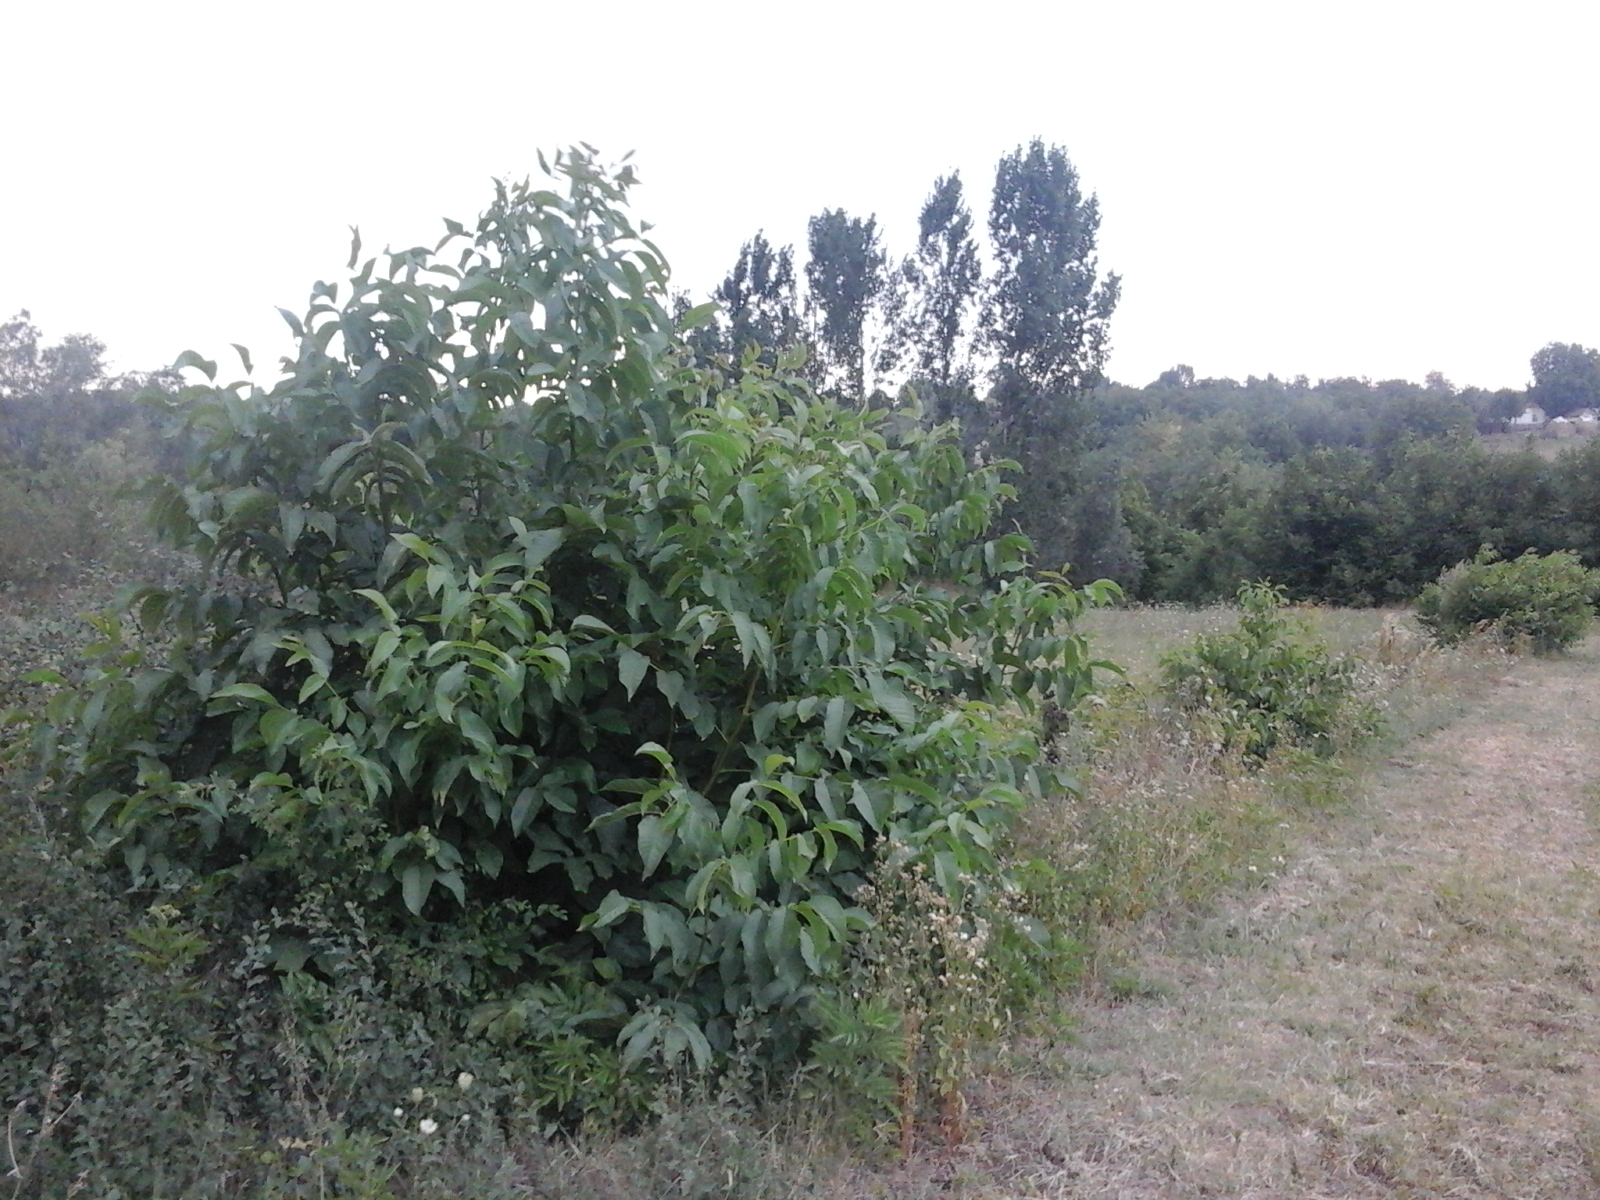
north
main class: Grassland
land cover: Grassland without tree/shrub cover
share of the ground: > 75 %
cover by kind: herbaceous plants 100 %
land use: Agriculture (excluding fallow land and kitchen gardens)
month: August
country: RO
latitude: 44.3327
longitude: 23.2793
